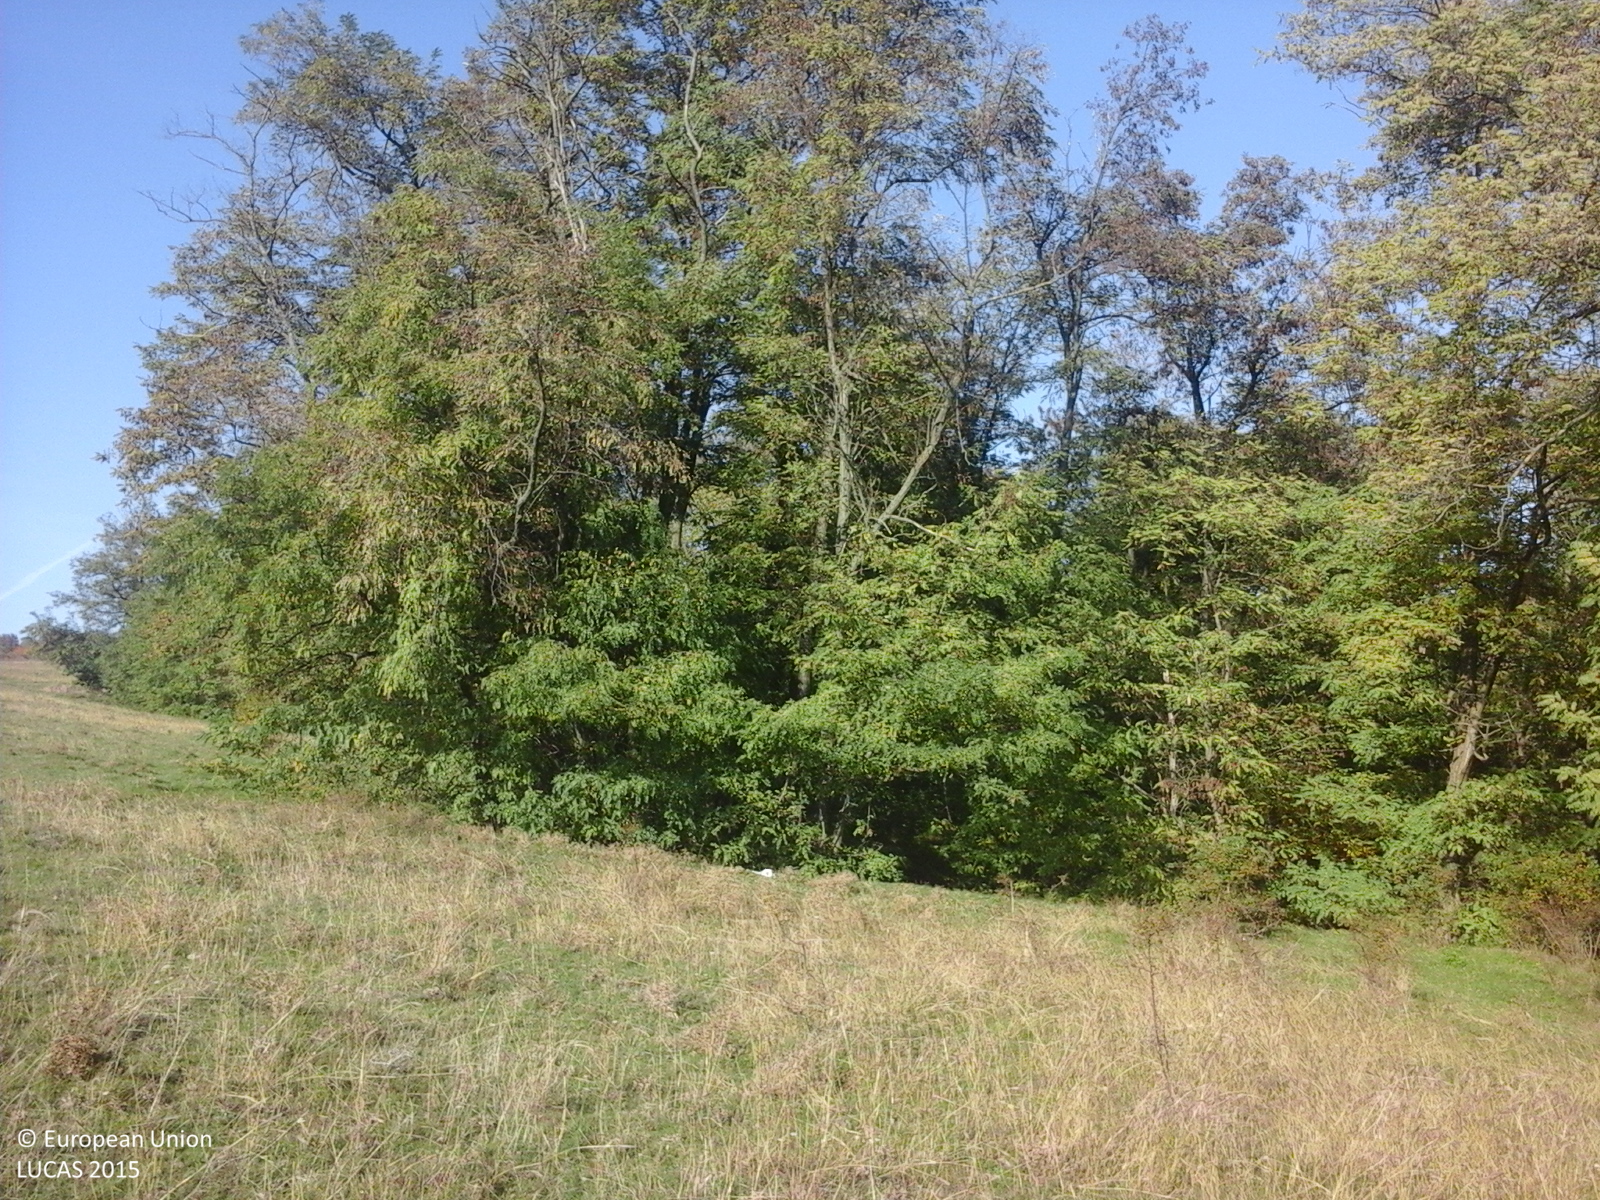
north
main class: Grassland
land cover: Grassland without tree/shrub cover
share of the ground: > 75 %
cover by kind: herbaceous plants 100 %
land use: Agriculture (excluding fallow land and kitchen gardens)
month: October
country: RO
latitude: 46.0912
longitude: 27.0503
